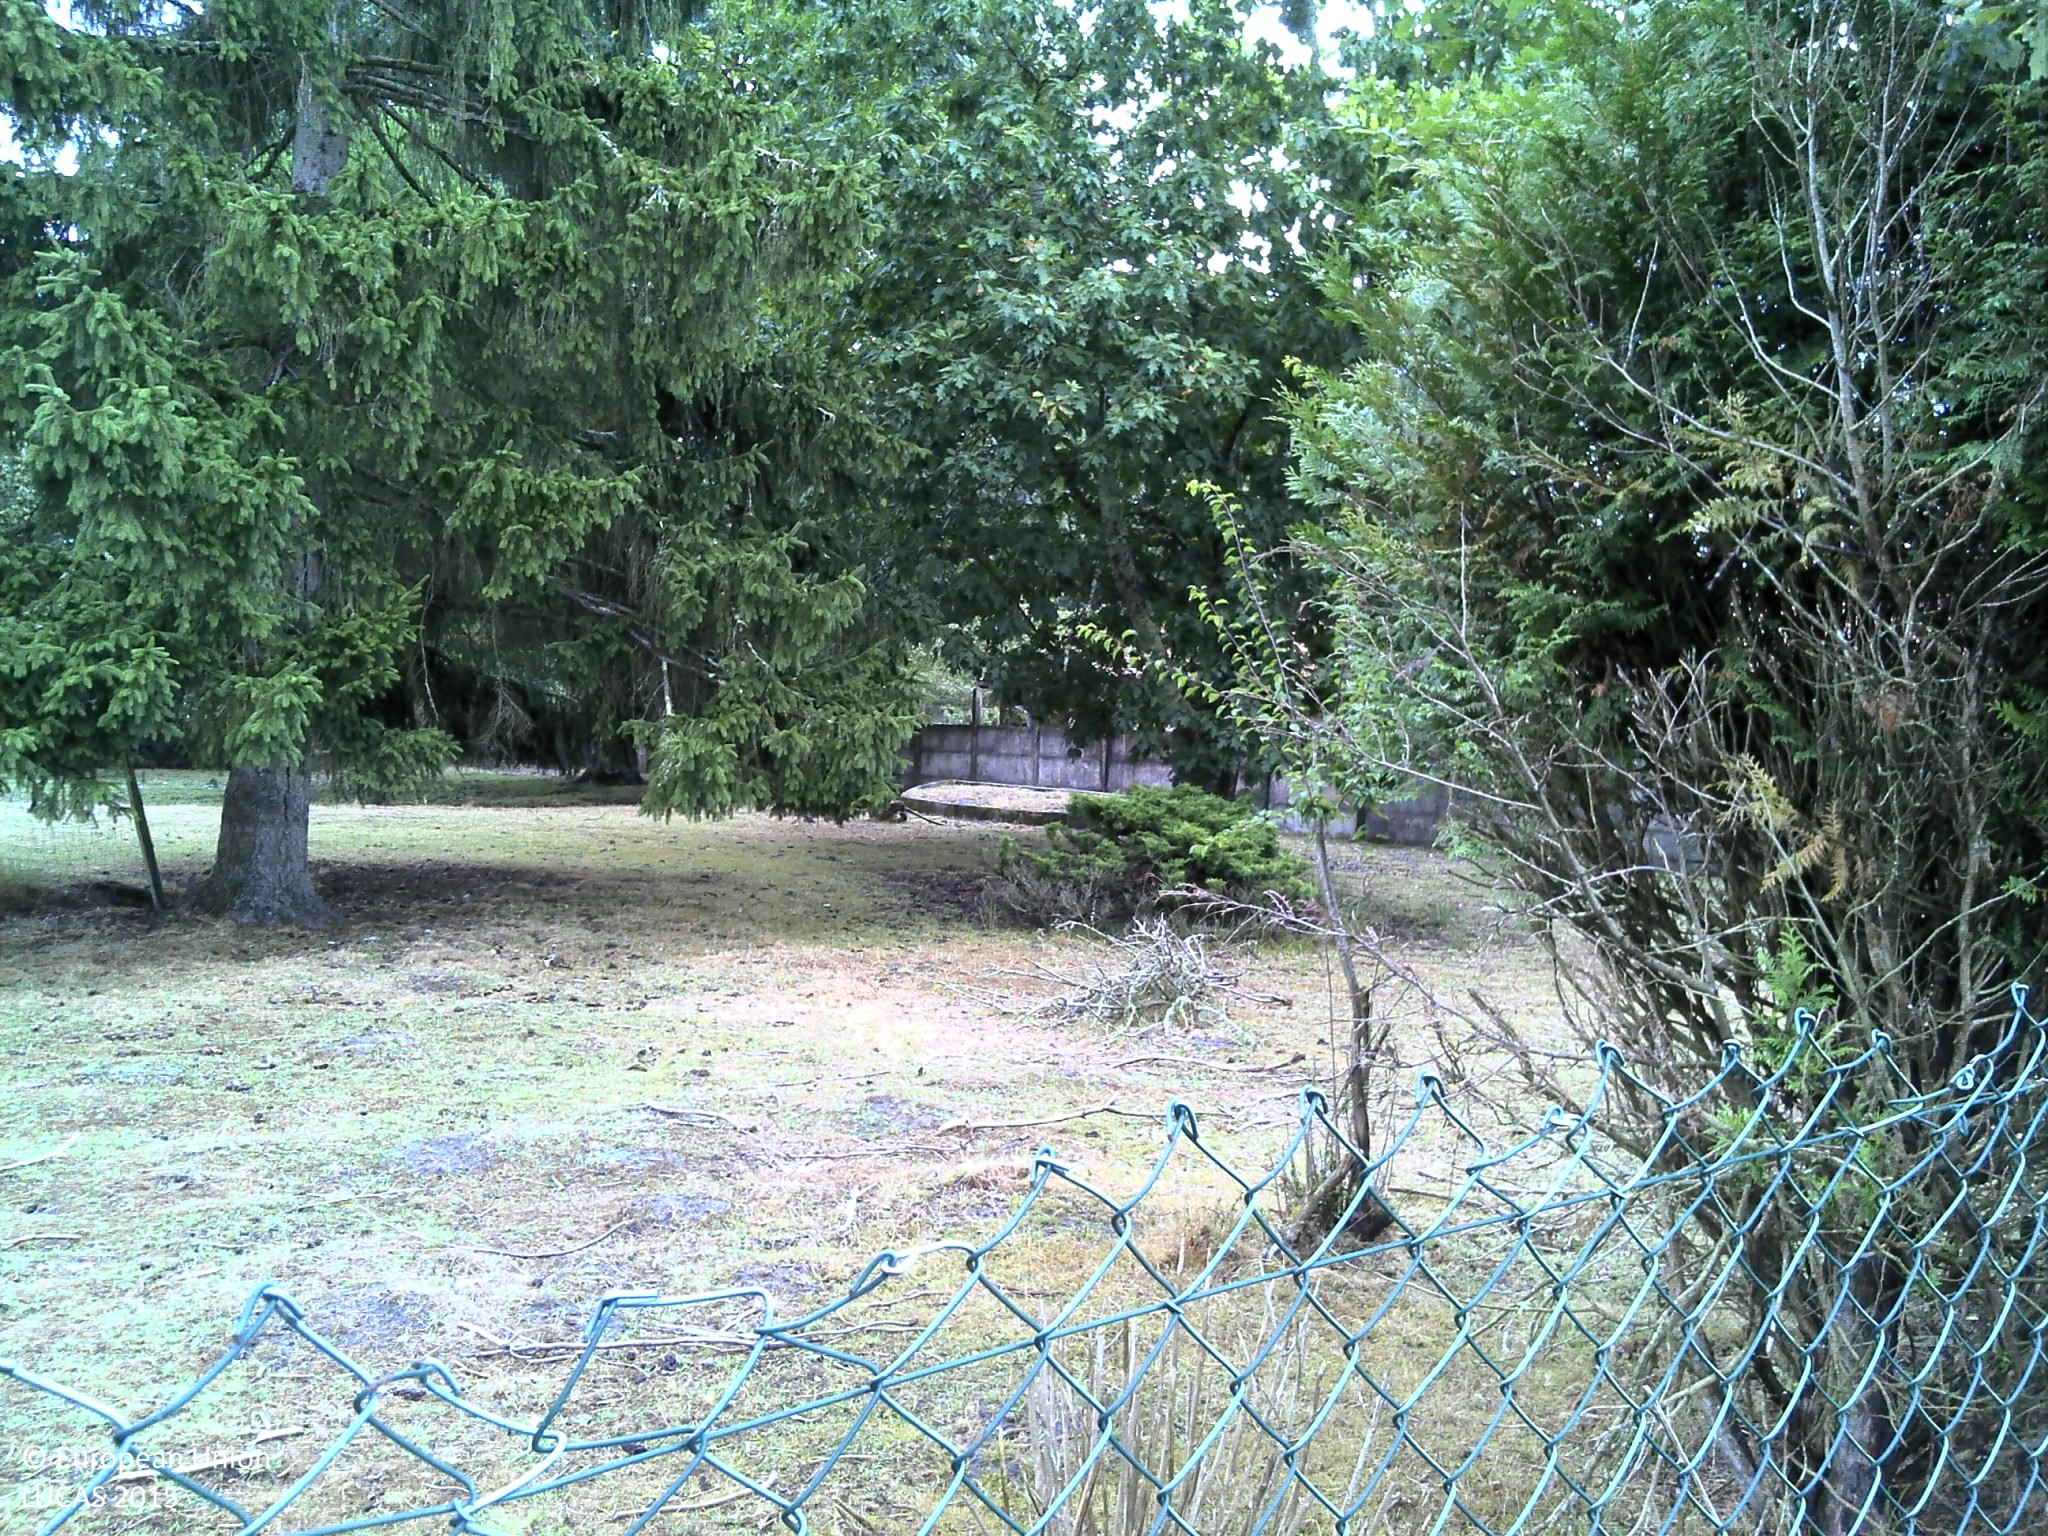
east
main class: Grassland
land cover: Grassland without tree/shrub cover
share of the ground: > 75 %
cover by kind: herbaceous plants 100 %
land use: Residential
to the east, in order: Grassland without tree/shrub cover; Artificial constructions in urban areas
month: July
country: FR
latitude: 44.7546
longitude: -0.7442
